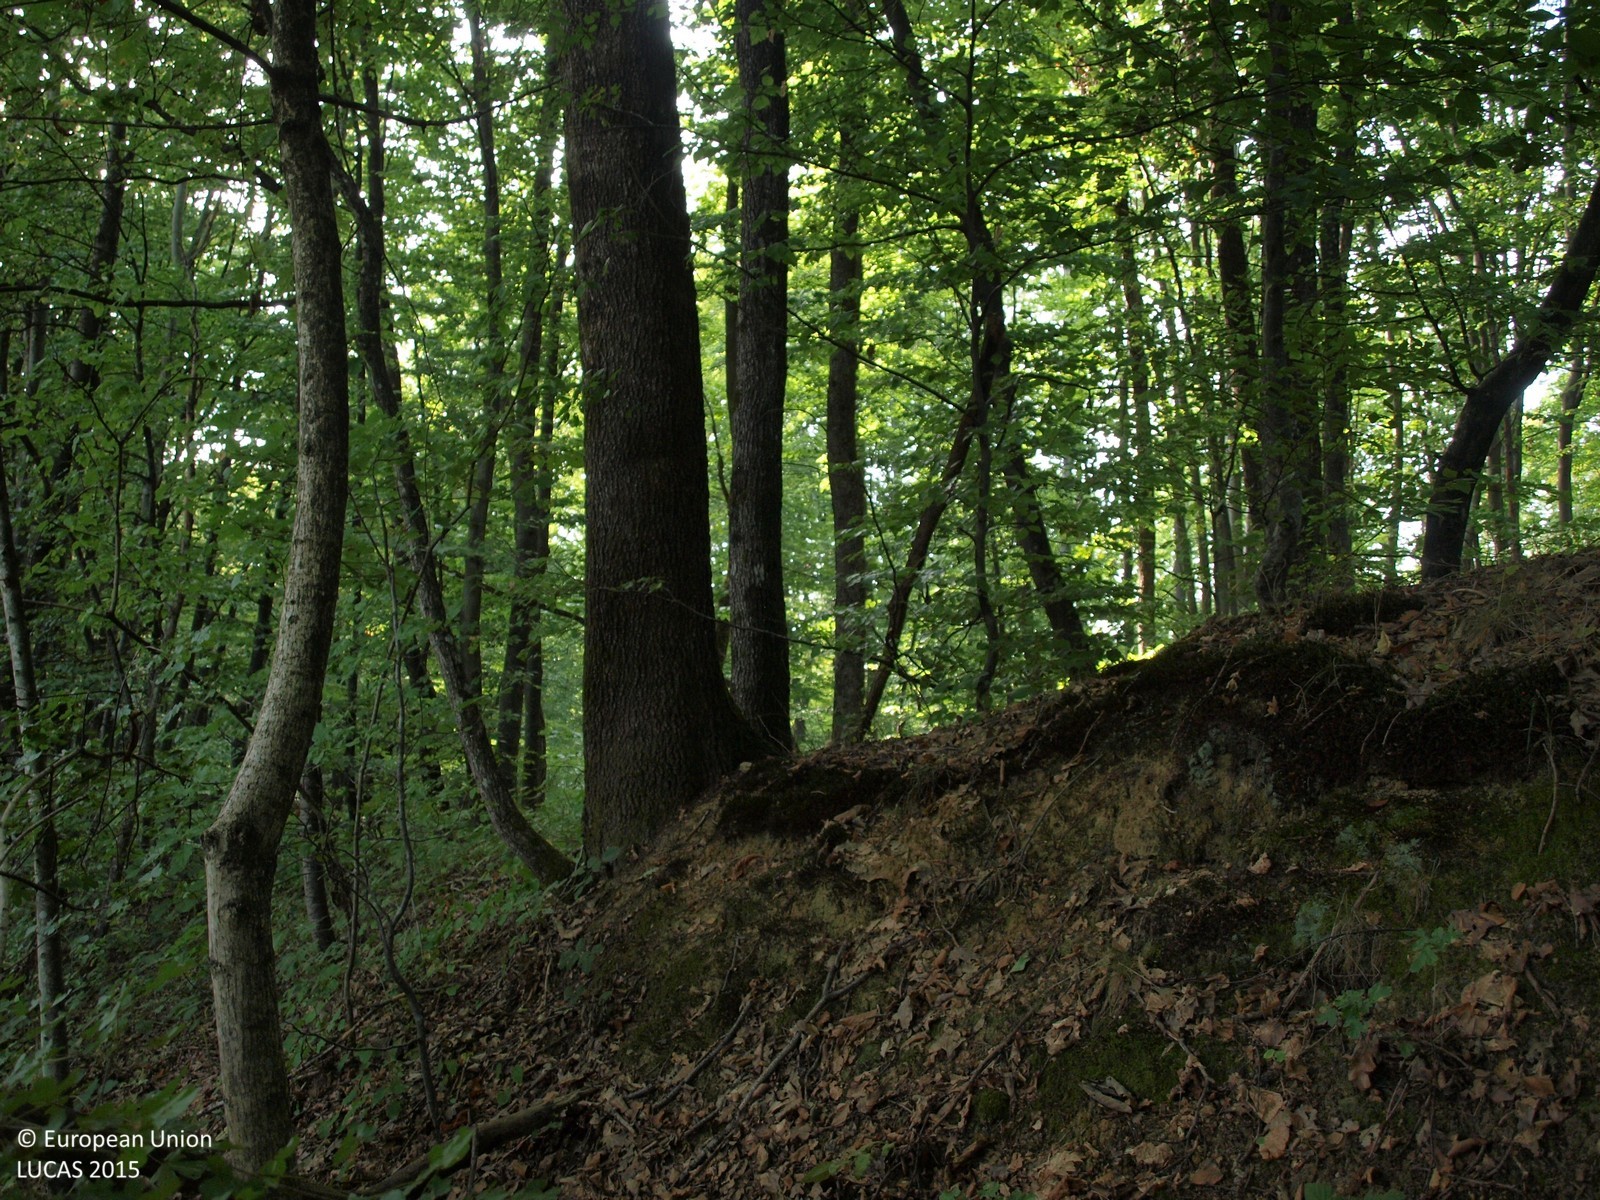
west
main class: Woodland
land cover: Broadleaved woodland
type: mesophytic deciduous forest
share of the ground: > 75 %
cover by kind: broadleaved forest trees 100 %
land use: Forestry
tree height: > 5 m
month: September
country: HR
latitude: 45.6012
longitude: 16.0616
